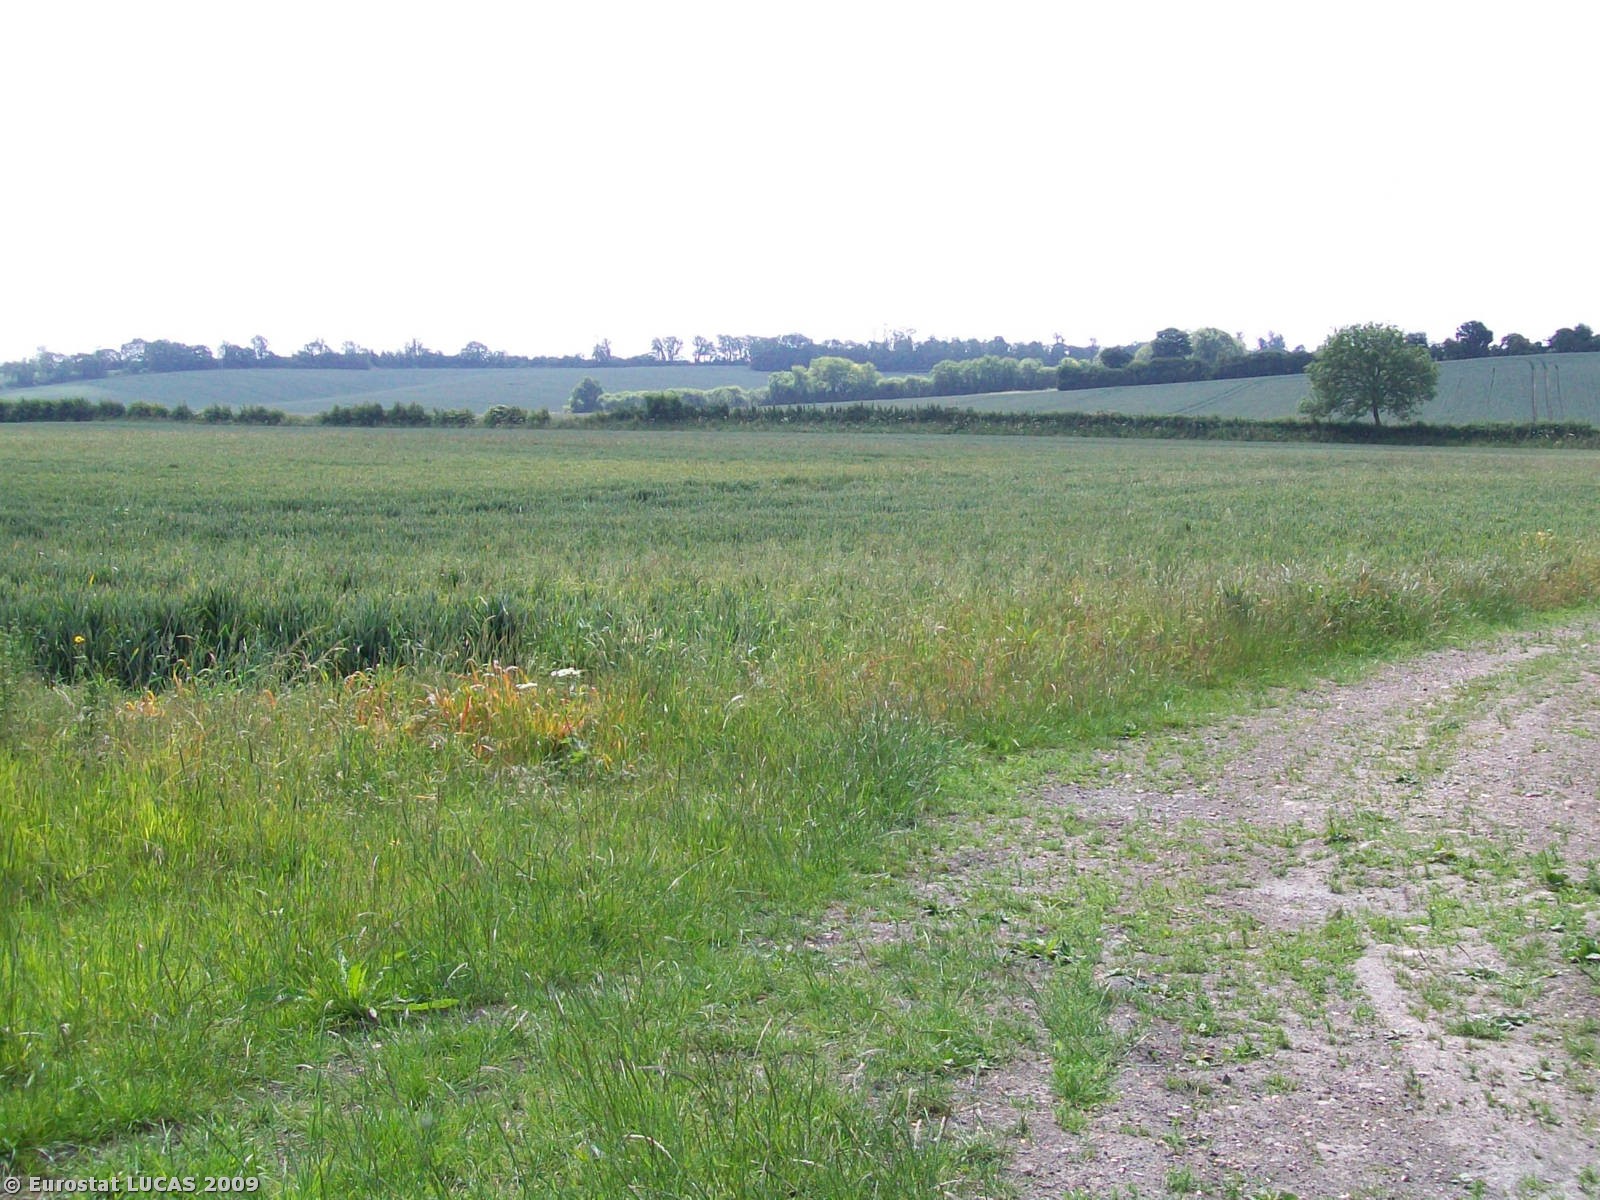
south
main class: Cropland
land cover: Common wheat
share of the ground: > 75 %
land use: Agriculture (excluding fallow land and kitchen gardens)
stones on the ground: < 10 %
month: June
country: GB
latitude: 52.1571
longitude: 0.0427
